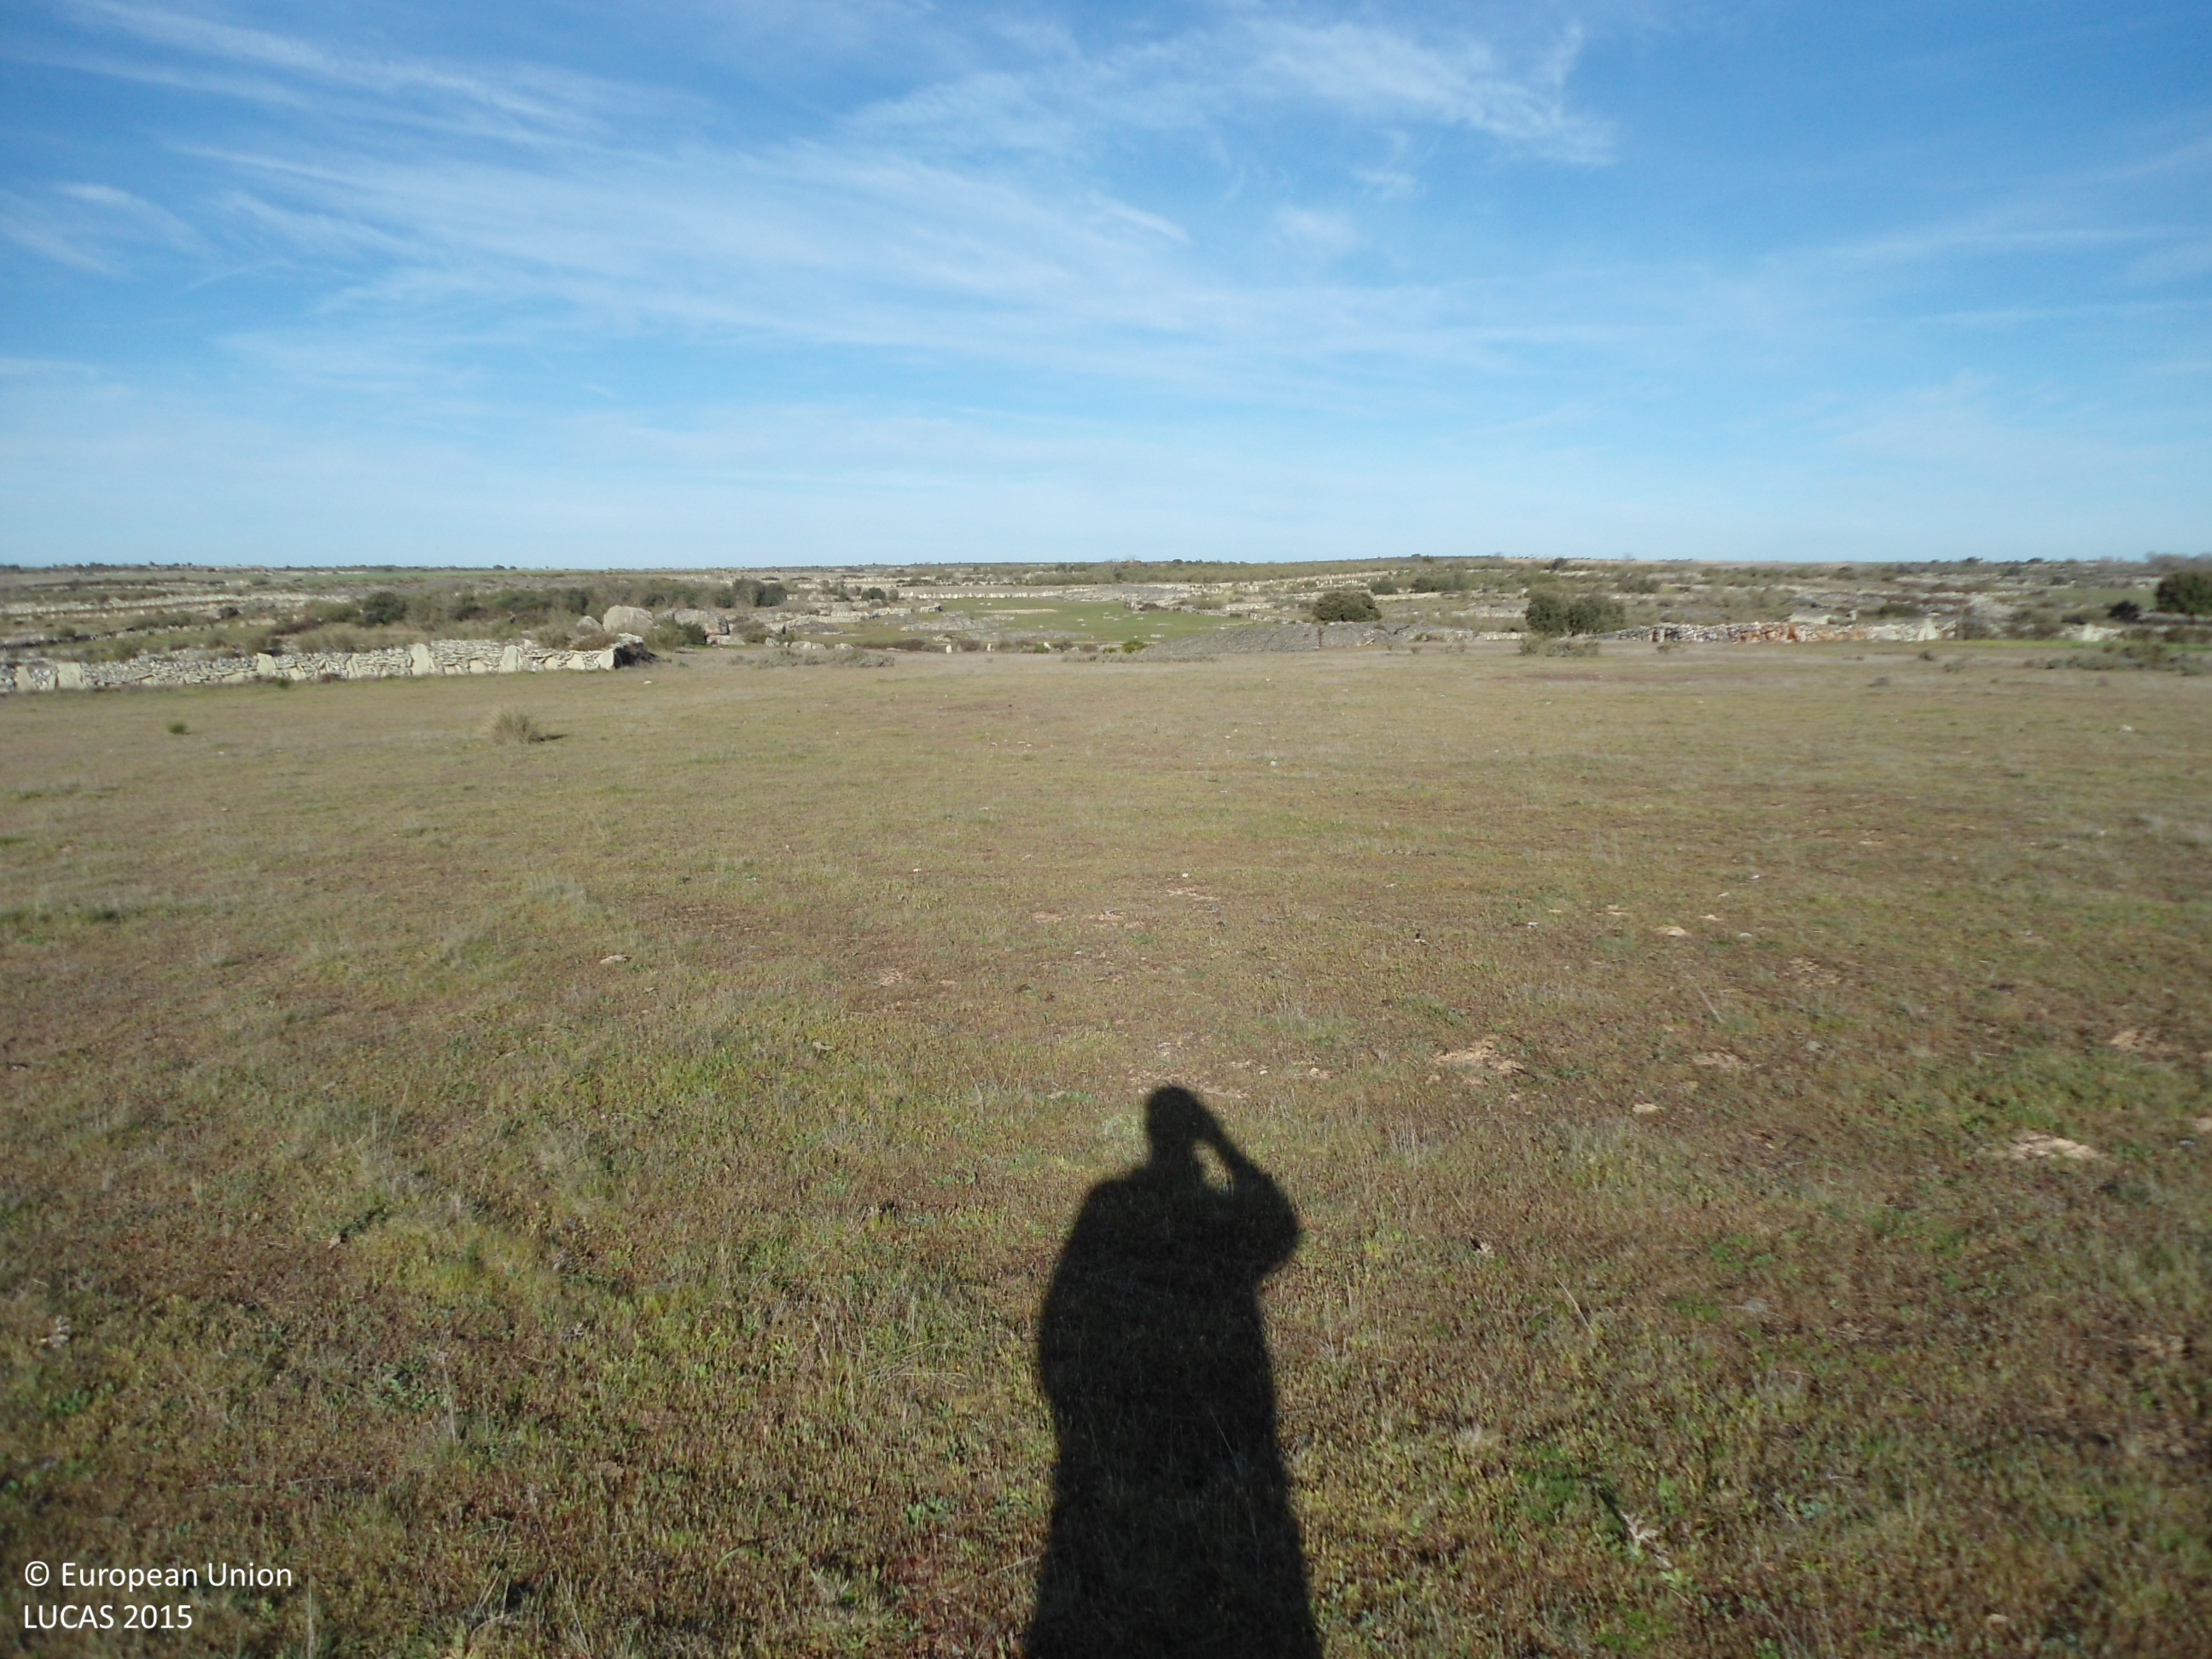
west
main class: Grassland
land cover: Grassland without tree/shrub cover
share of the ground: > 75 %
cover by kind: herbaceous plants 100 %
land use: Agriculture (excluding fallow land and kitchen gardens)
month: April
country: ES
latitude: 41.5481
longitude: -6.0499
